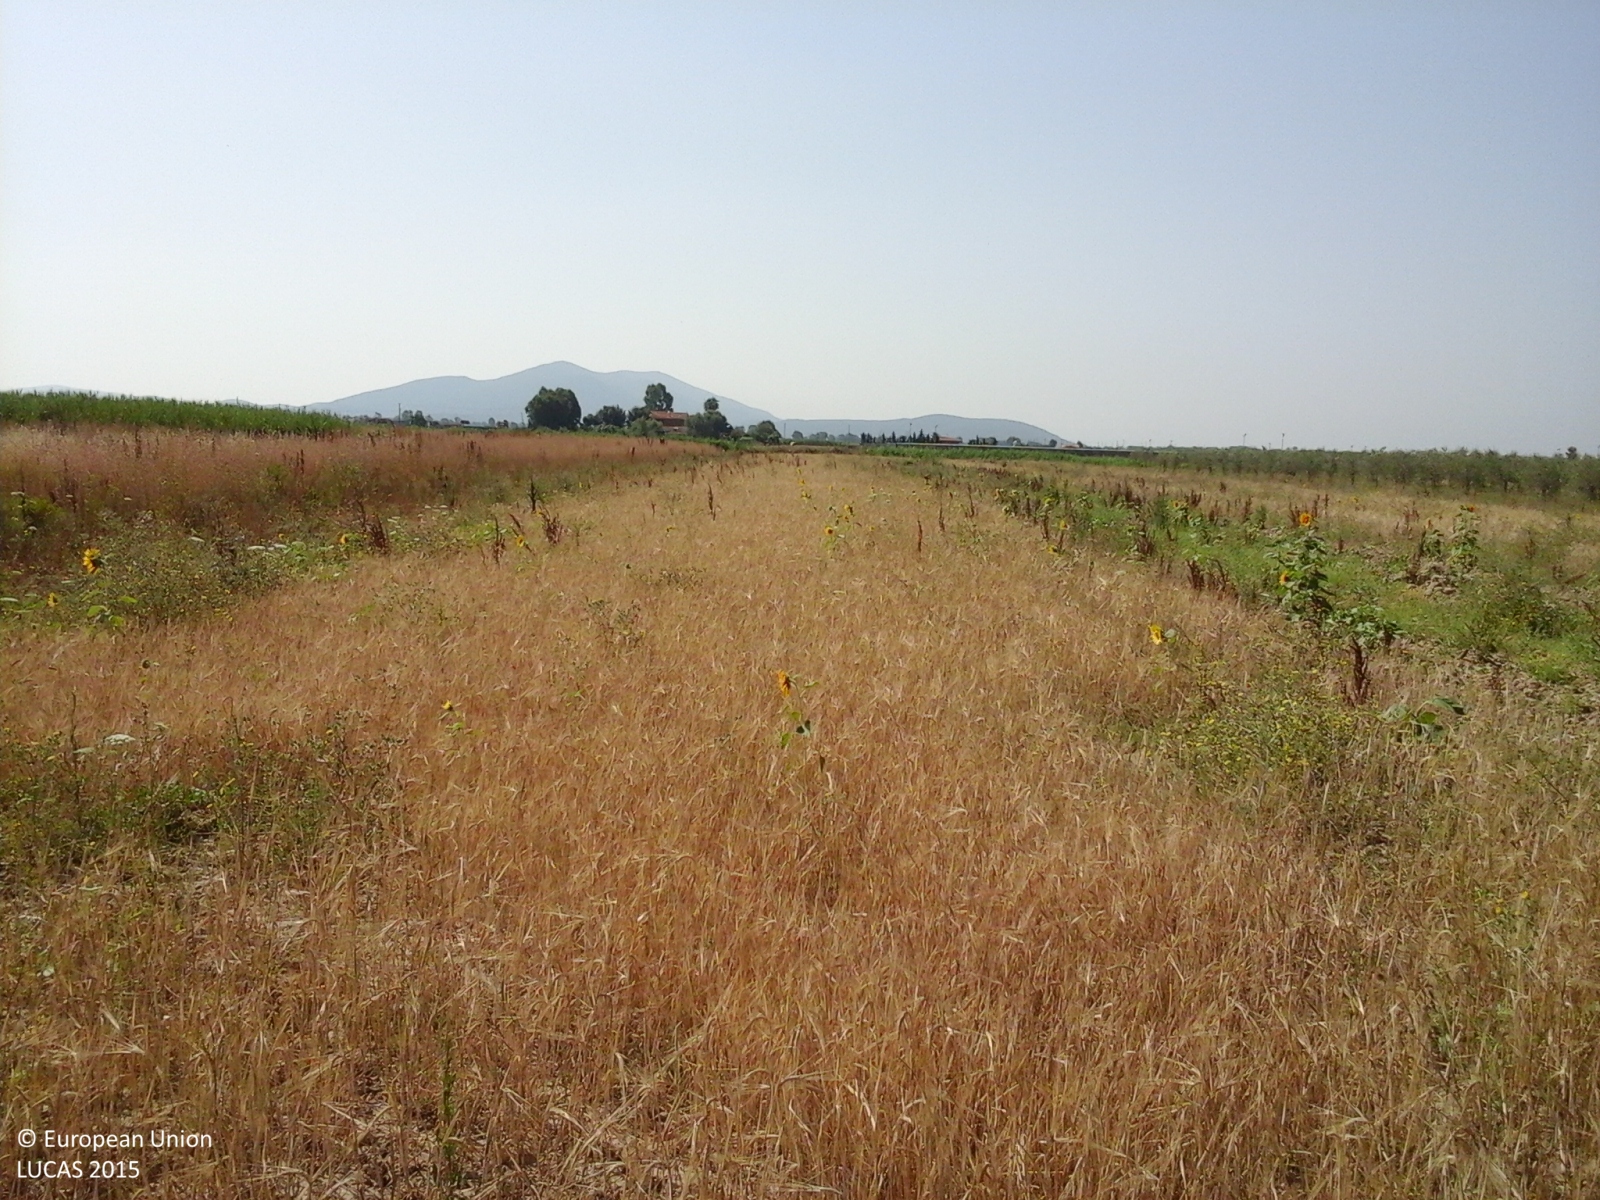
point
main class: Cropland
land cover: Barley
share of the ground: > 75 %
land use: Agriculture (excluding fallow land and kitchen gardens)
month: July
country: IT
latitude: 42.7210
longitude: 11.0346
